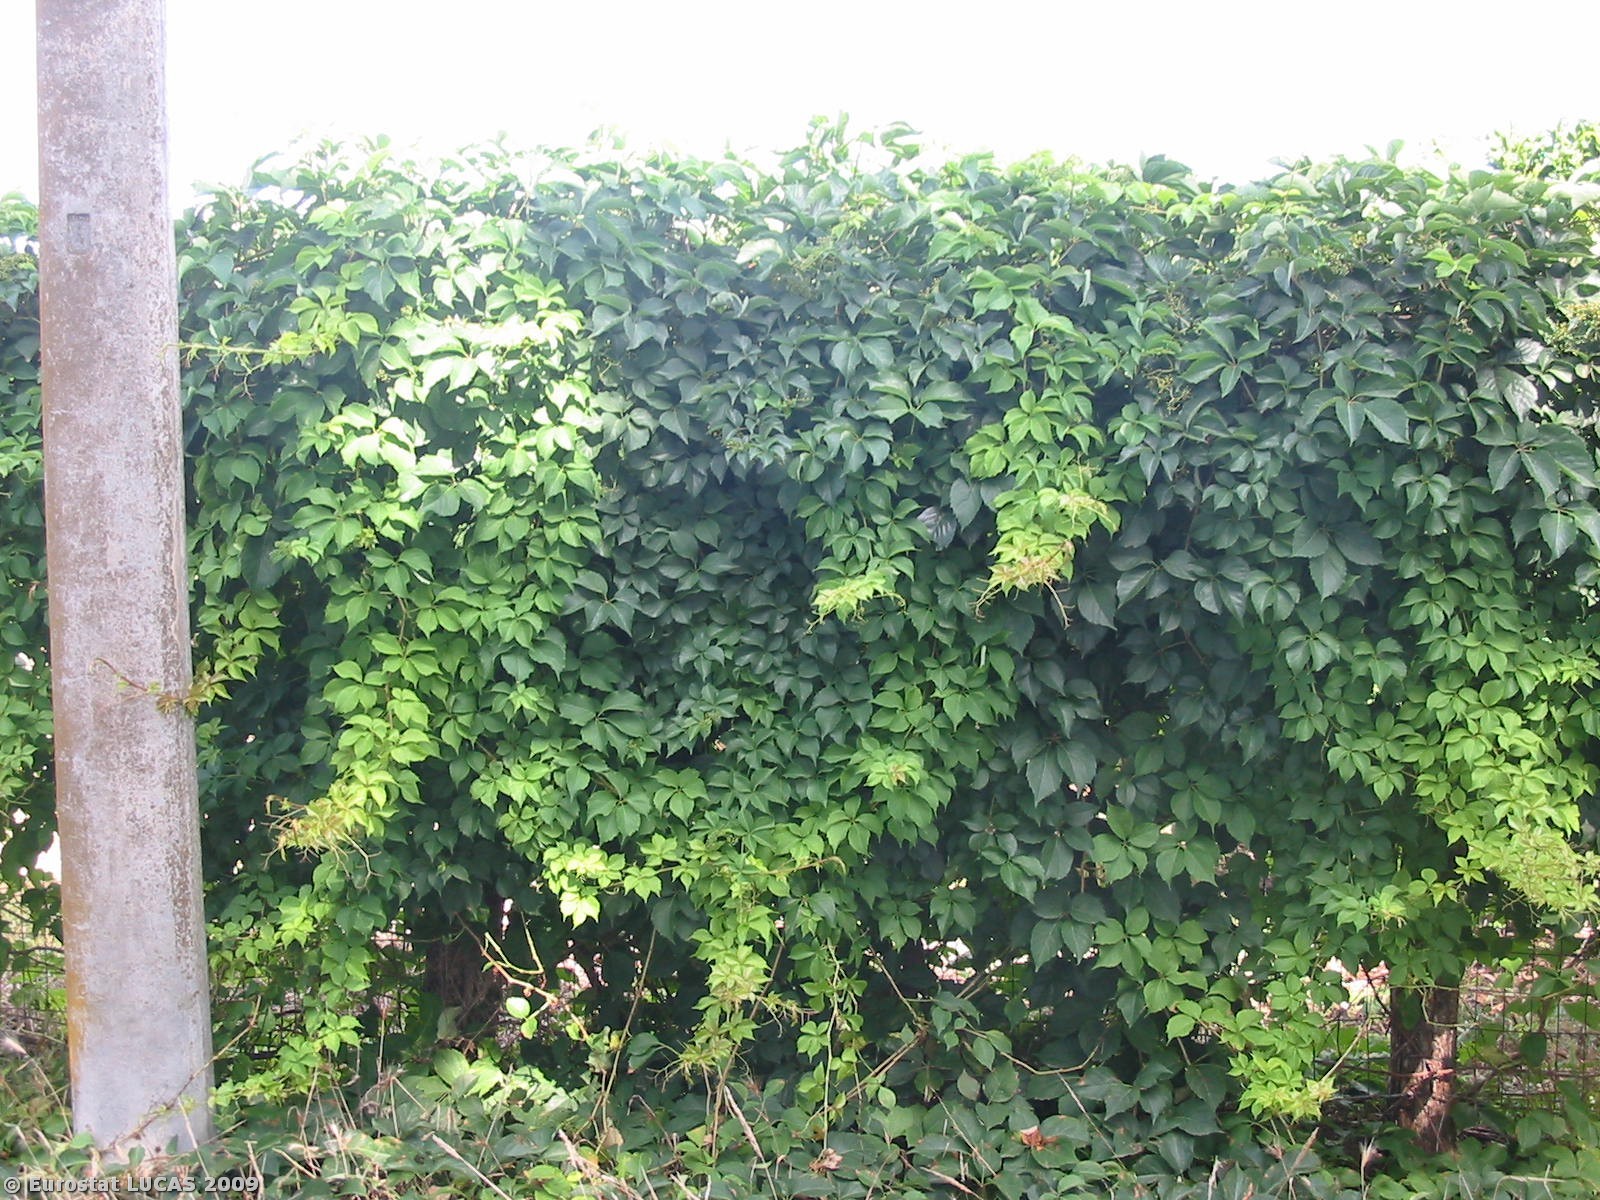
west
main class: Cropland
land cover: Oranges
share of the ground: > 75 %
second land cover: Bare land
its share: > 75 %
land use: Agriculture (excluding fallow land and kitchen gardens)
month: July
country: IT
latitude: 38.4893
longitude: 15.9384
